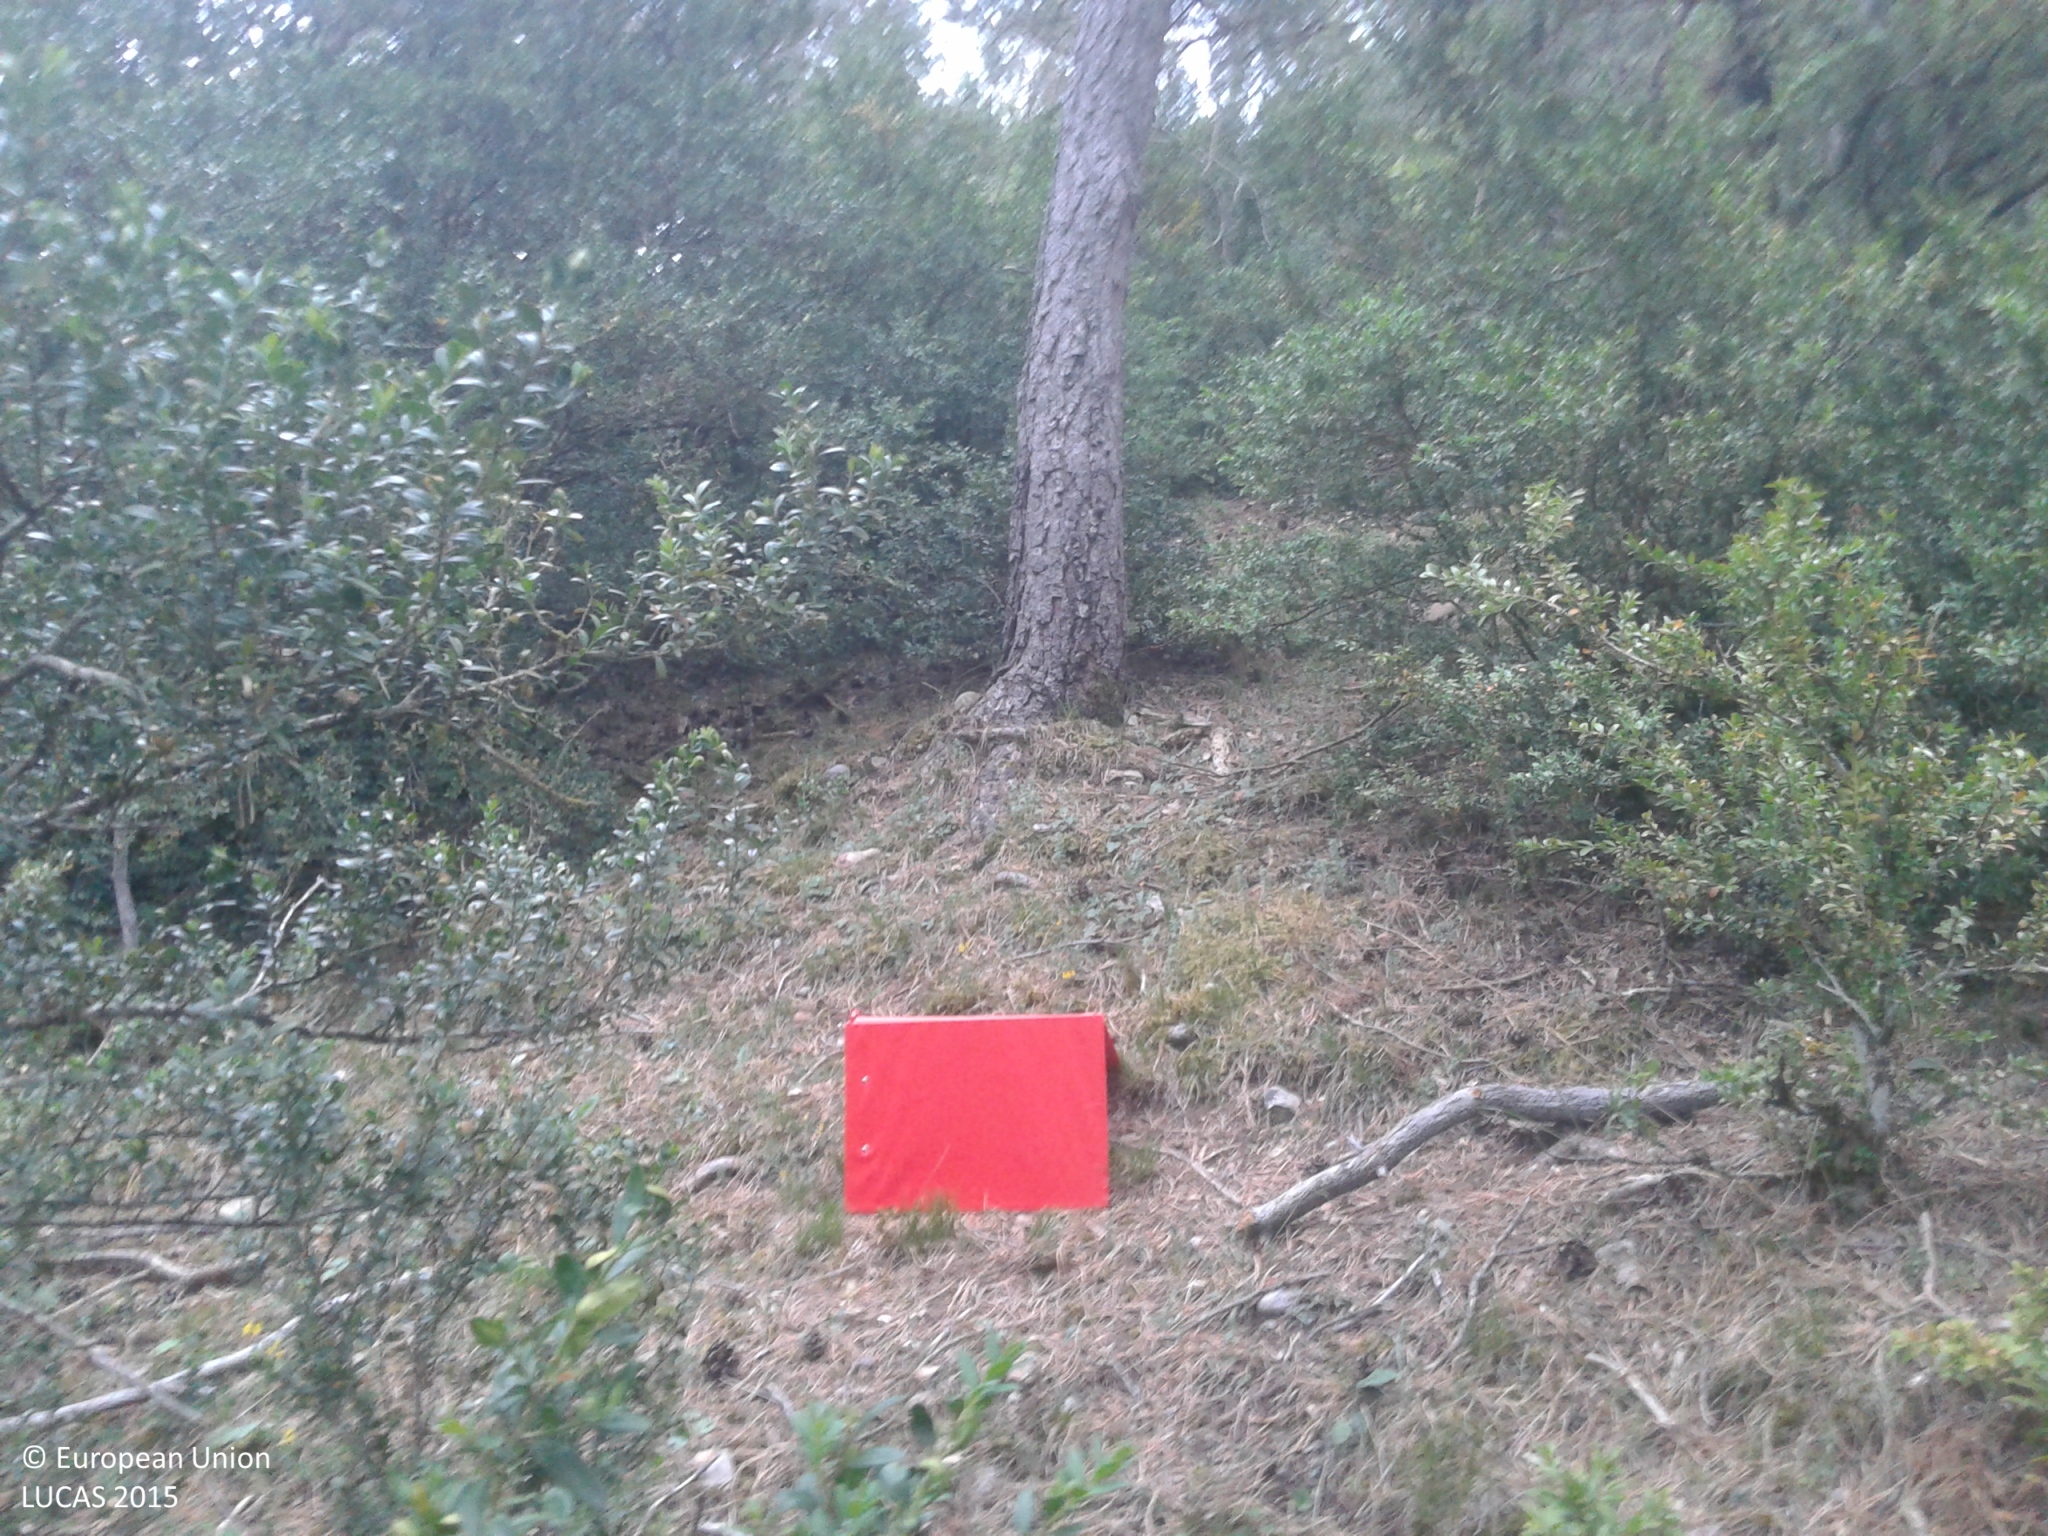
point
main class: Woodland
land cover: Pine dominated coniferous woodland
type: coniferous forest of the mediterranean region
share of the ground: 50 - 75 %
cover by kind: coniferous forest trees 70 %, shrubs 25 %, herbaceous plants 5 %
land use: Semi-natural and natural areas not in use
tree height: > 5 m
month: May
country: ES
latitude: 42.0995
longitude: 1.5357
